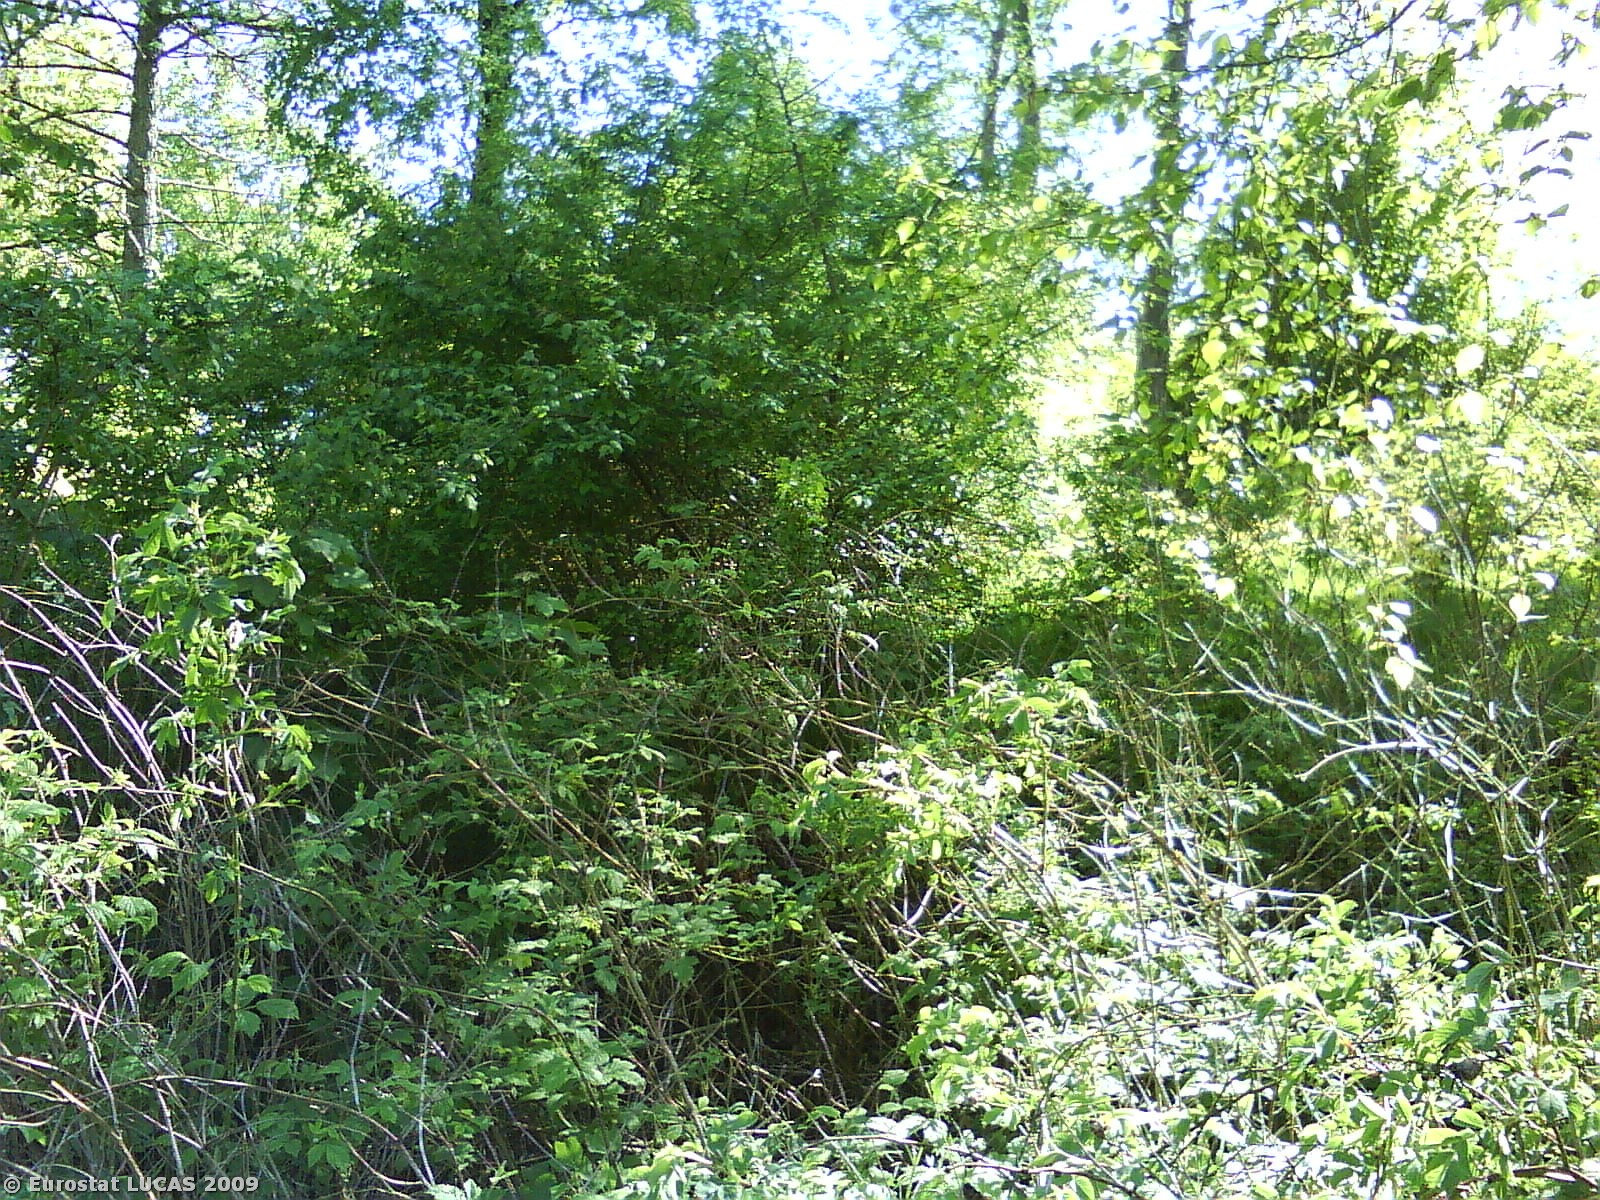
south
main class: Woodland
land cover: Broadleaved woodland
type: plantations and self-sown exotic forest
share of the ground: 25 - 50 %
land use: Forestry
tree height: > 5 m
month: May
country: DK
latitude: 56.4549
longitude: 10.7941
